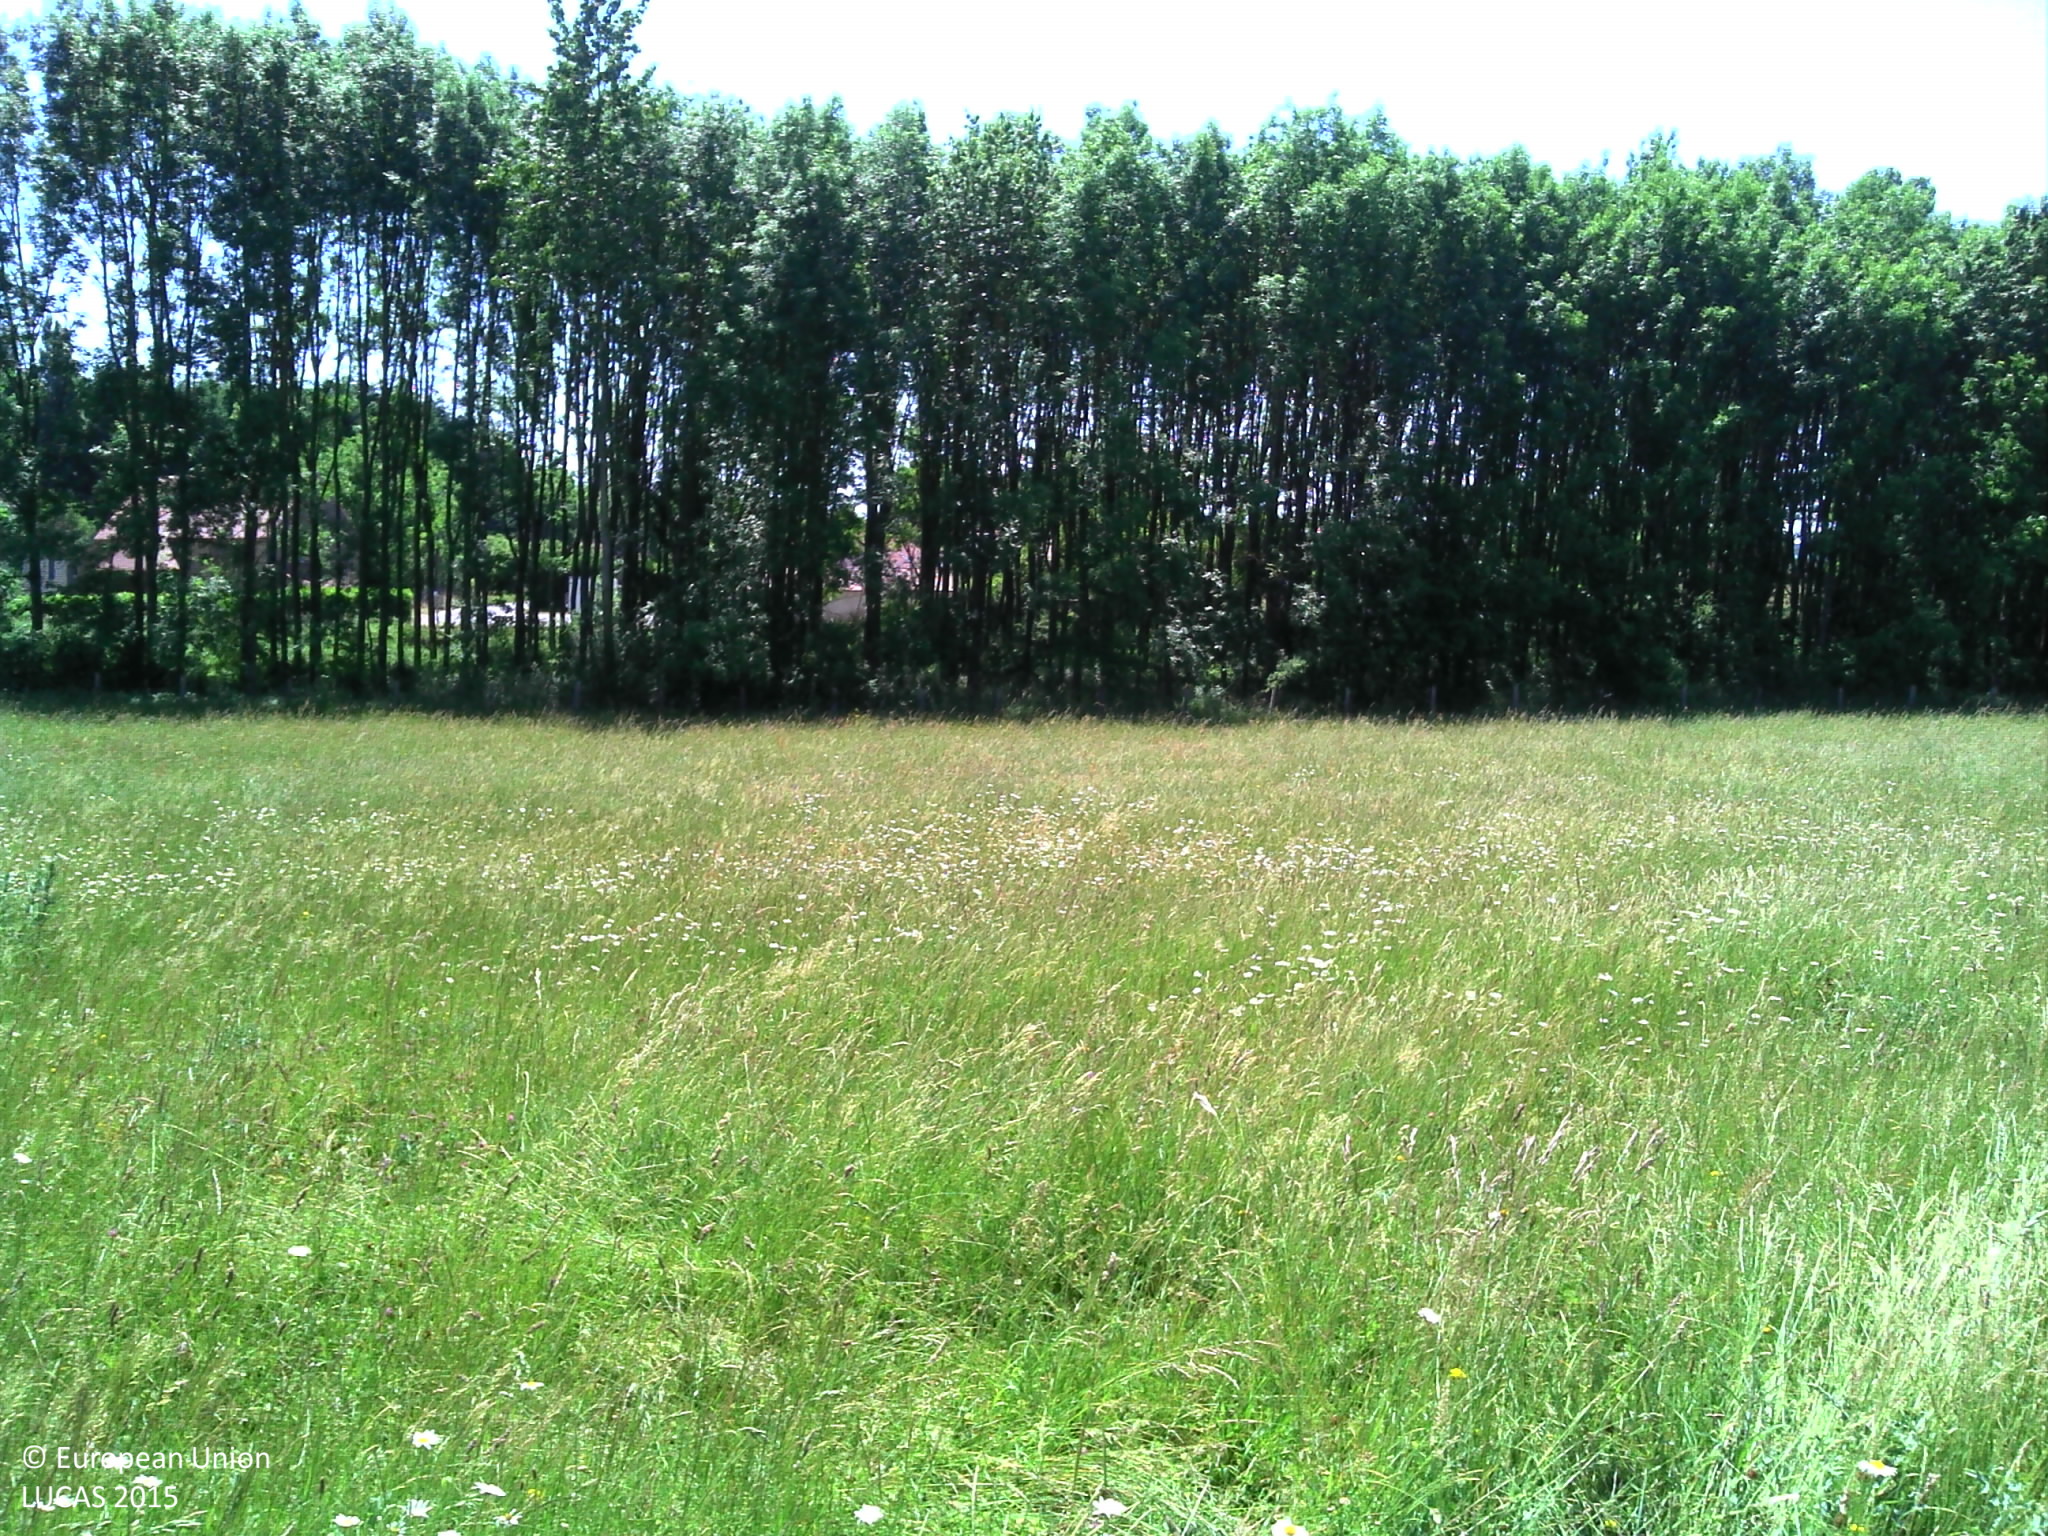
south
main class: Grassland
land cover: Grassland without tree/shrub cover
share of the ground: > 75 %
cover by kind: herbaceous plants 100 %
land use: Agriculture (excluding fallow land and kitchen gardens)
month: June
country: FR
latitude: 46.9689
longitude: 2.9638
